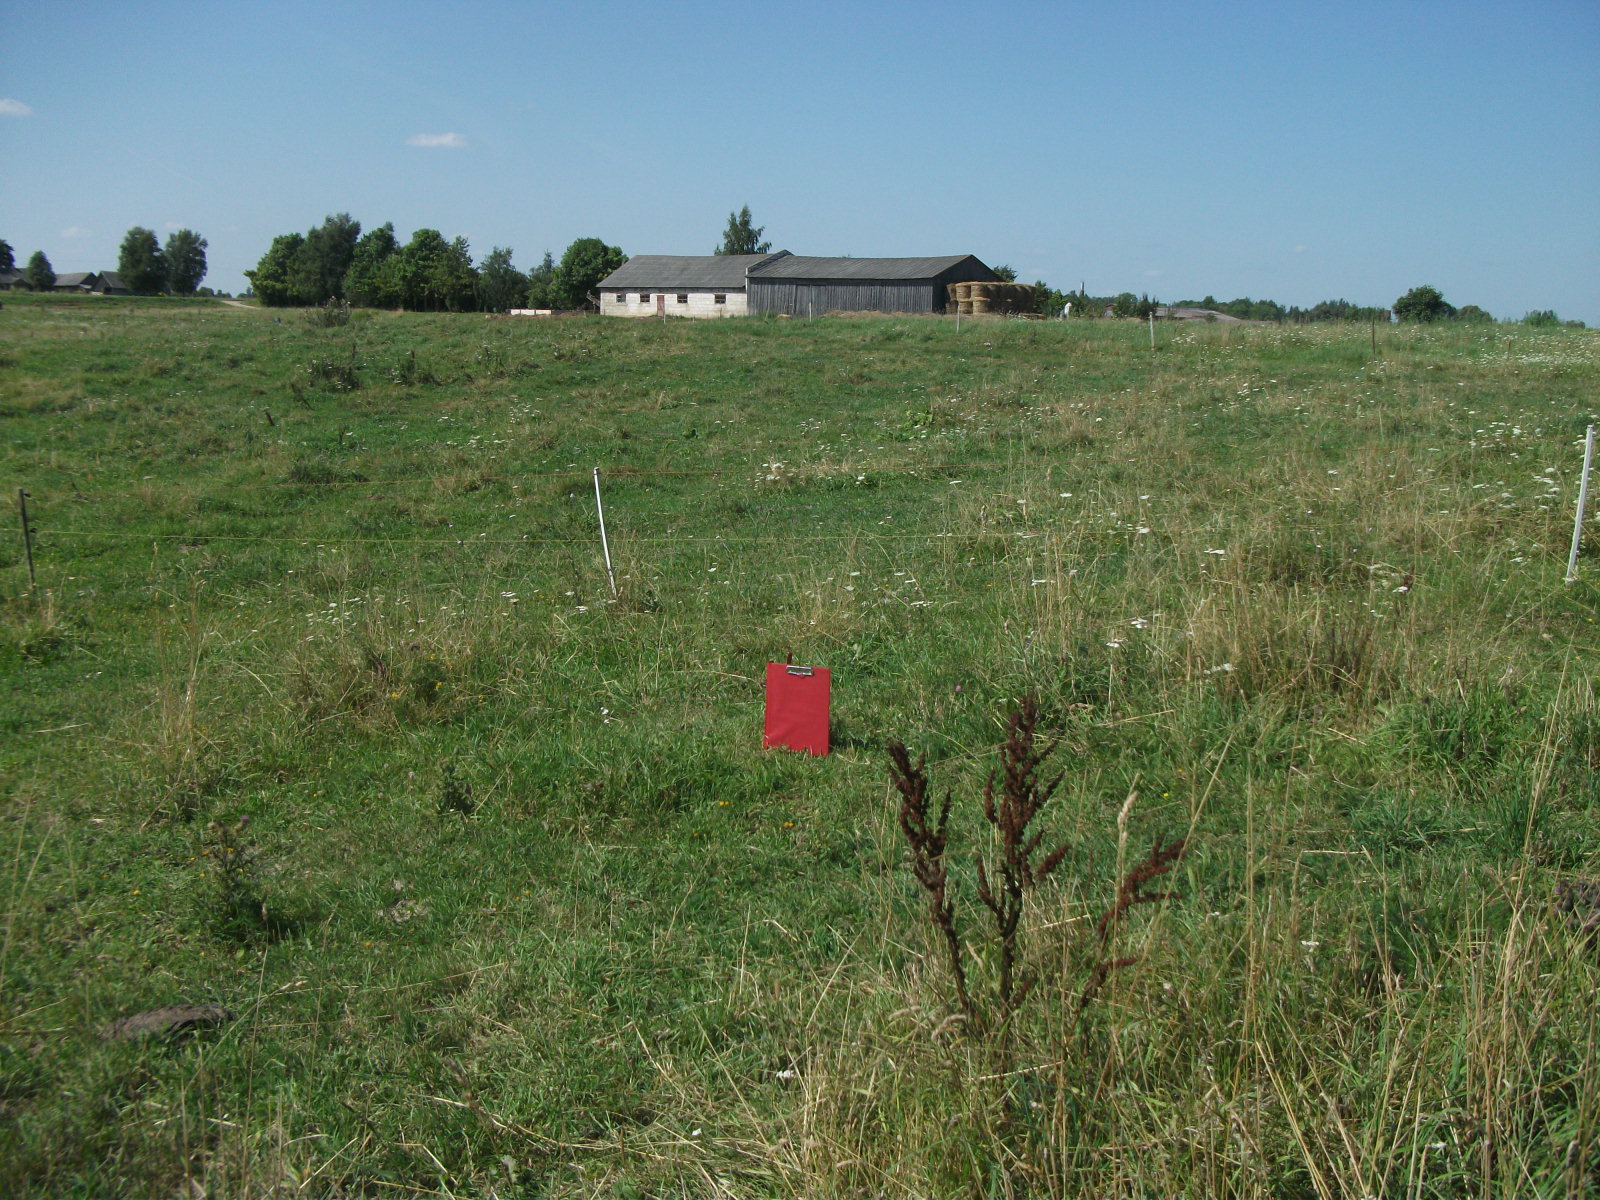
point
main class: Grassland
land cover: Grassland without tree/shrub cover
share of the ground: > 75 %
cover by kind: herbaceous plants 95 %, unconsolidated bare surface 5 %
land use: Agriculture (excluding fallow land and kitchen gardens)
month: August
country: LV
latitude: 56.6626
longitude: 26.5789
